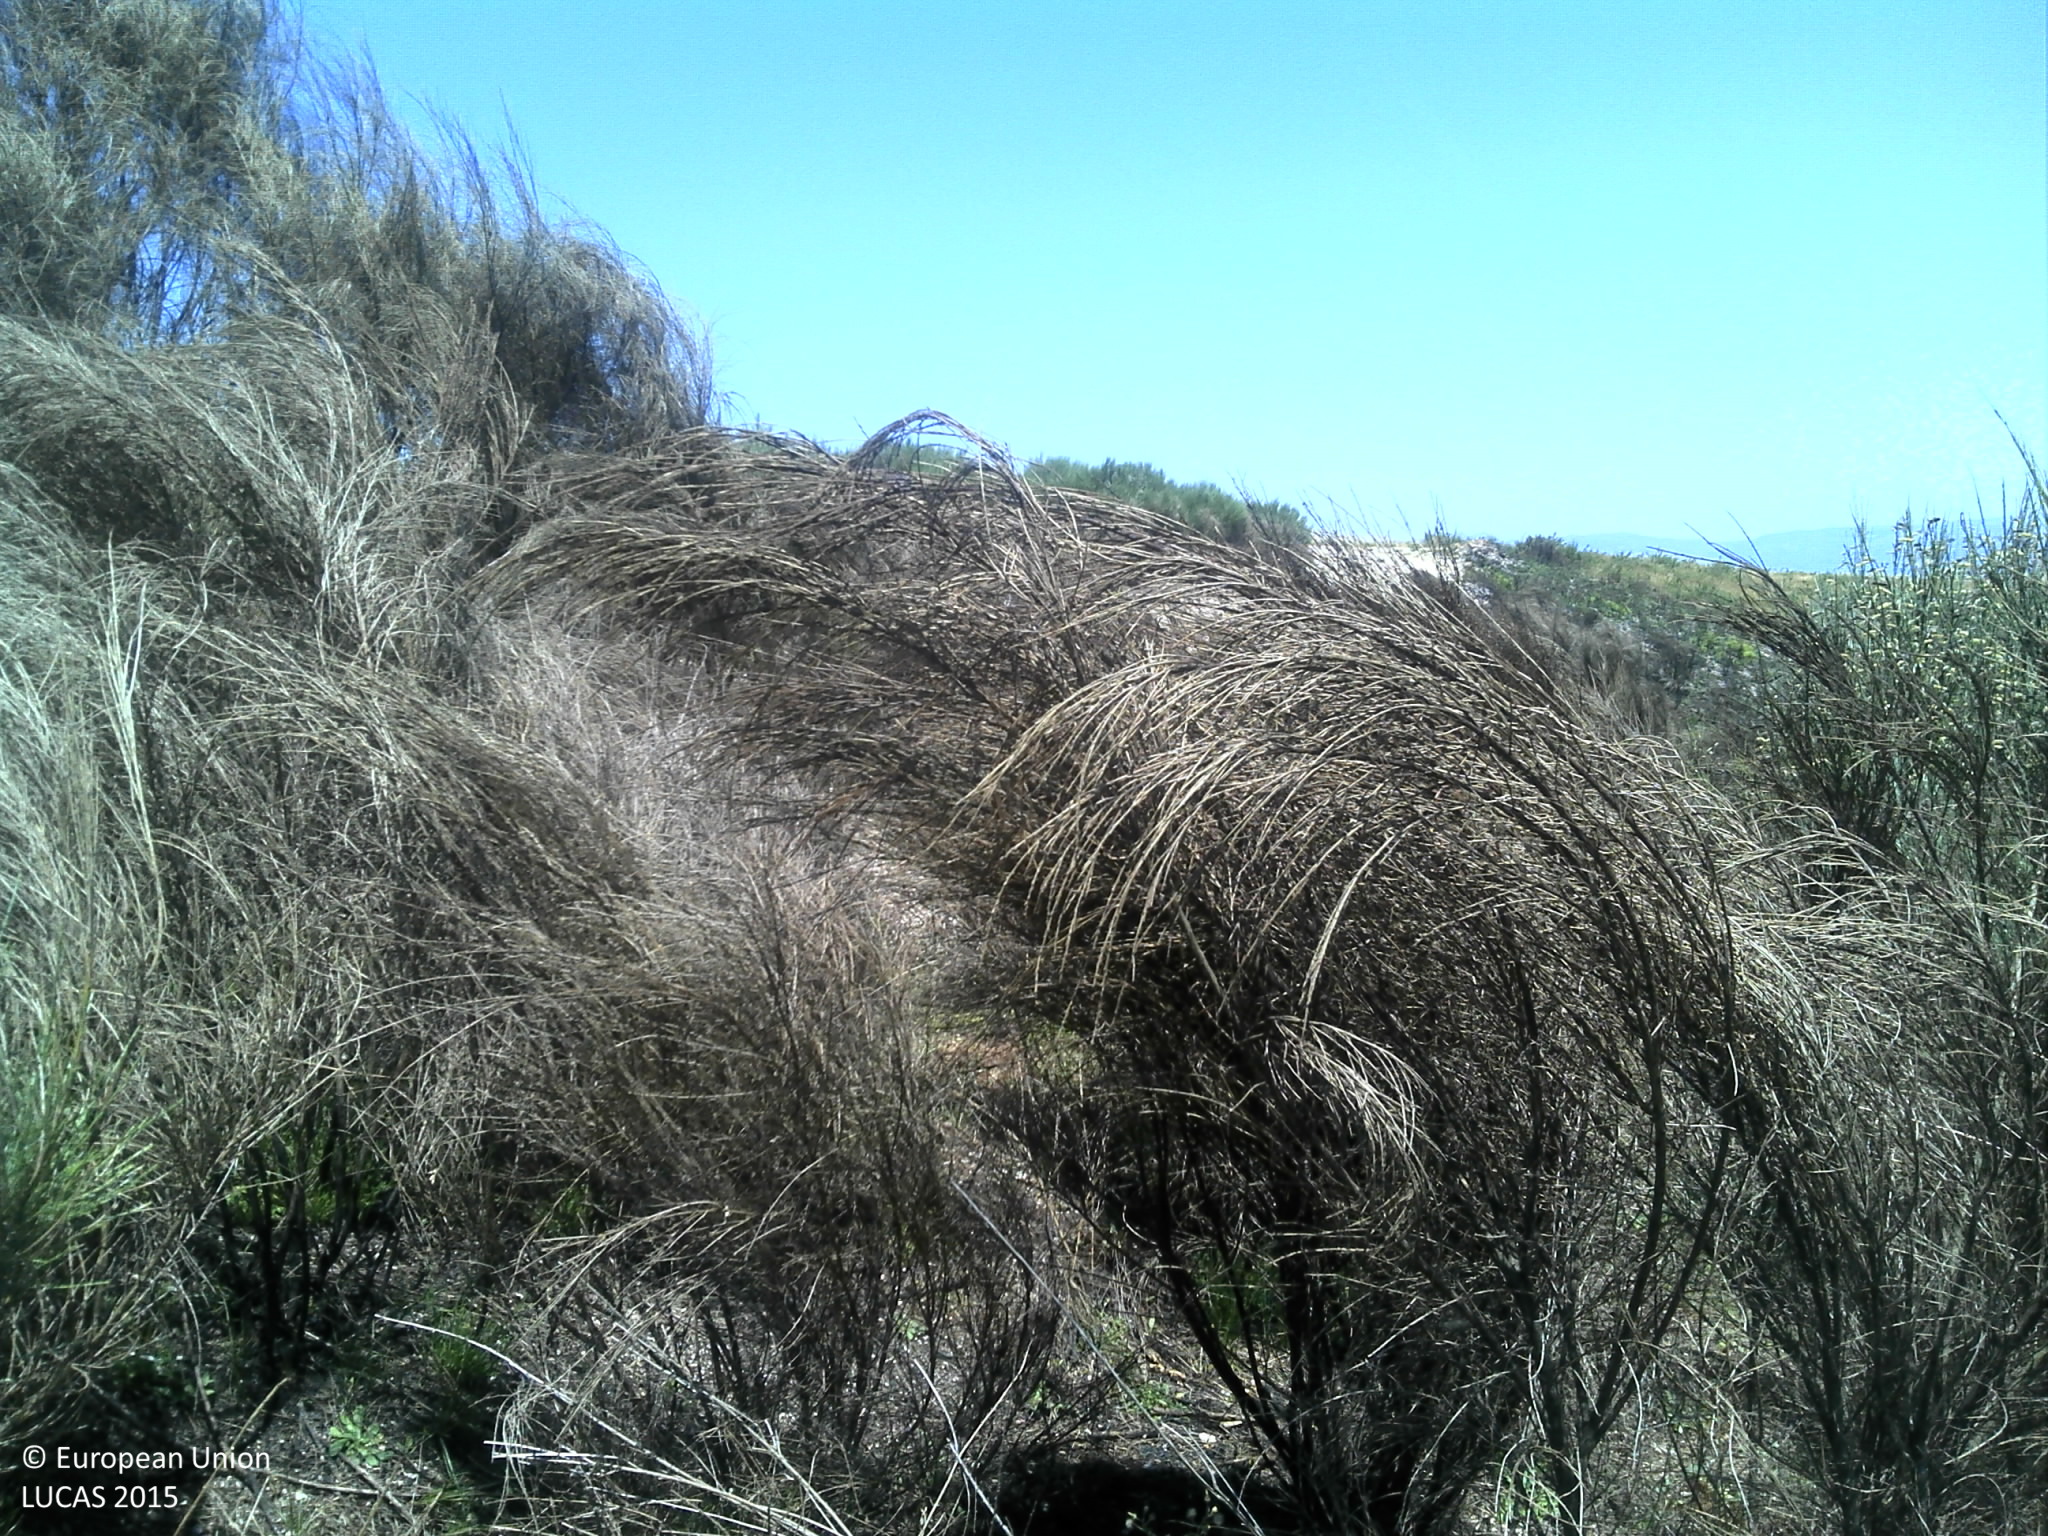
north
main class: Shrubland
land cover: Shrubland without tree cover
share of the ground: > 75 %
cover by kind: shrubs 80 %, herbaceous plants 15 %, unconsolidated bare surface 5 %
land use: Semi-natural and natural areas not in use
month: June
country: PT
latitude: 41.4220
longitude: -8.0528
